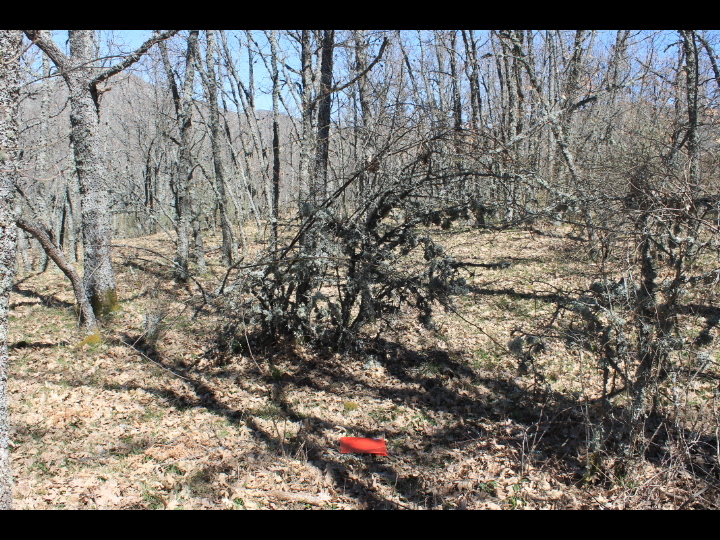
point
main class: Woodland
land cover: Broadleaved woodland
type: thermophilous deciduous forest
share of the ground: > 75 %
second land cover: Grassland without tree/shrub cover
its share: 10 - 25 %
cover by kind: broadleaved forest trees 90 %, herbaceous plants 5 %, lichens and mosses 5 %
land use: Forestry
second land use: Agriculture (excluding fallow land and kitchen gardens)
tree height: > 5 m
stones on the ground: < 10 %
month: April
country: ES
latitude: 40.9076
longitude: -3.9975
